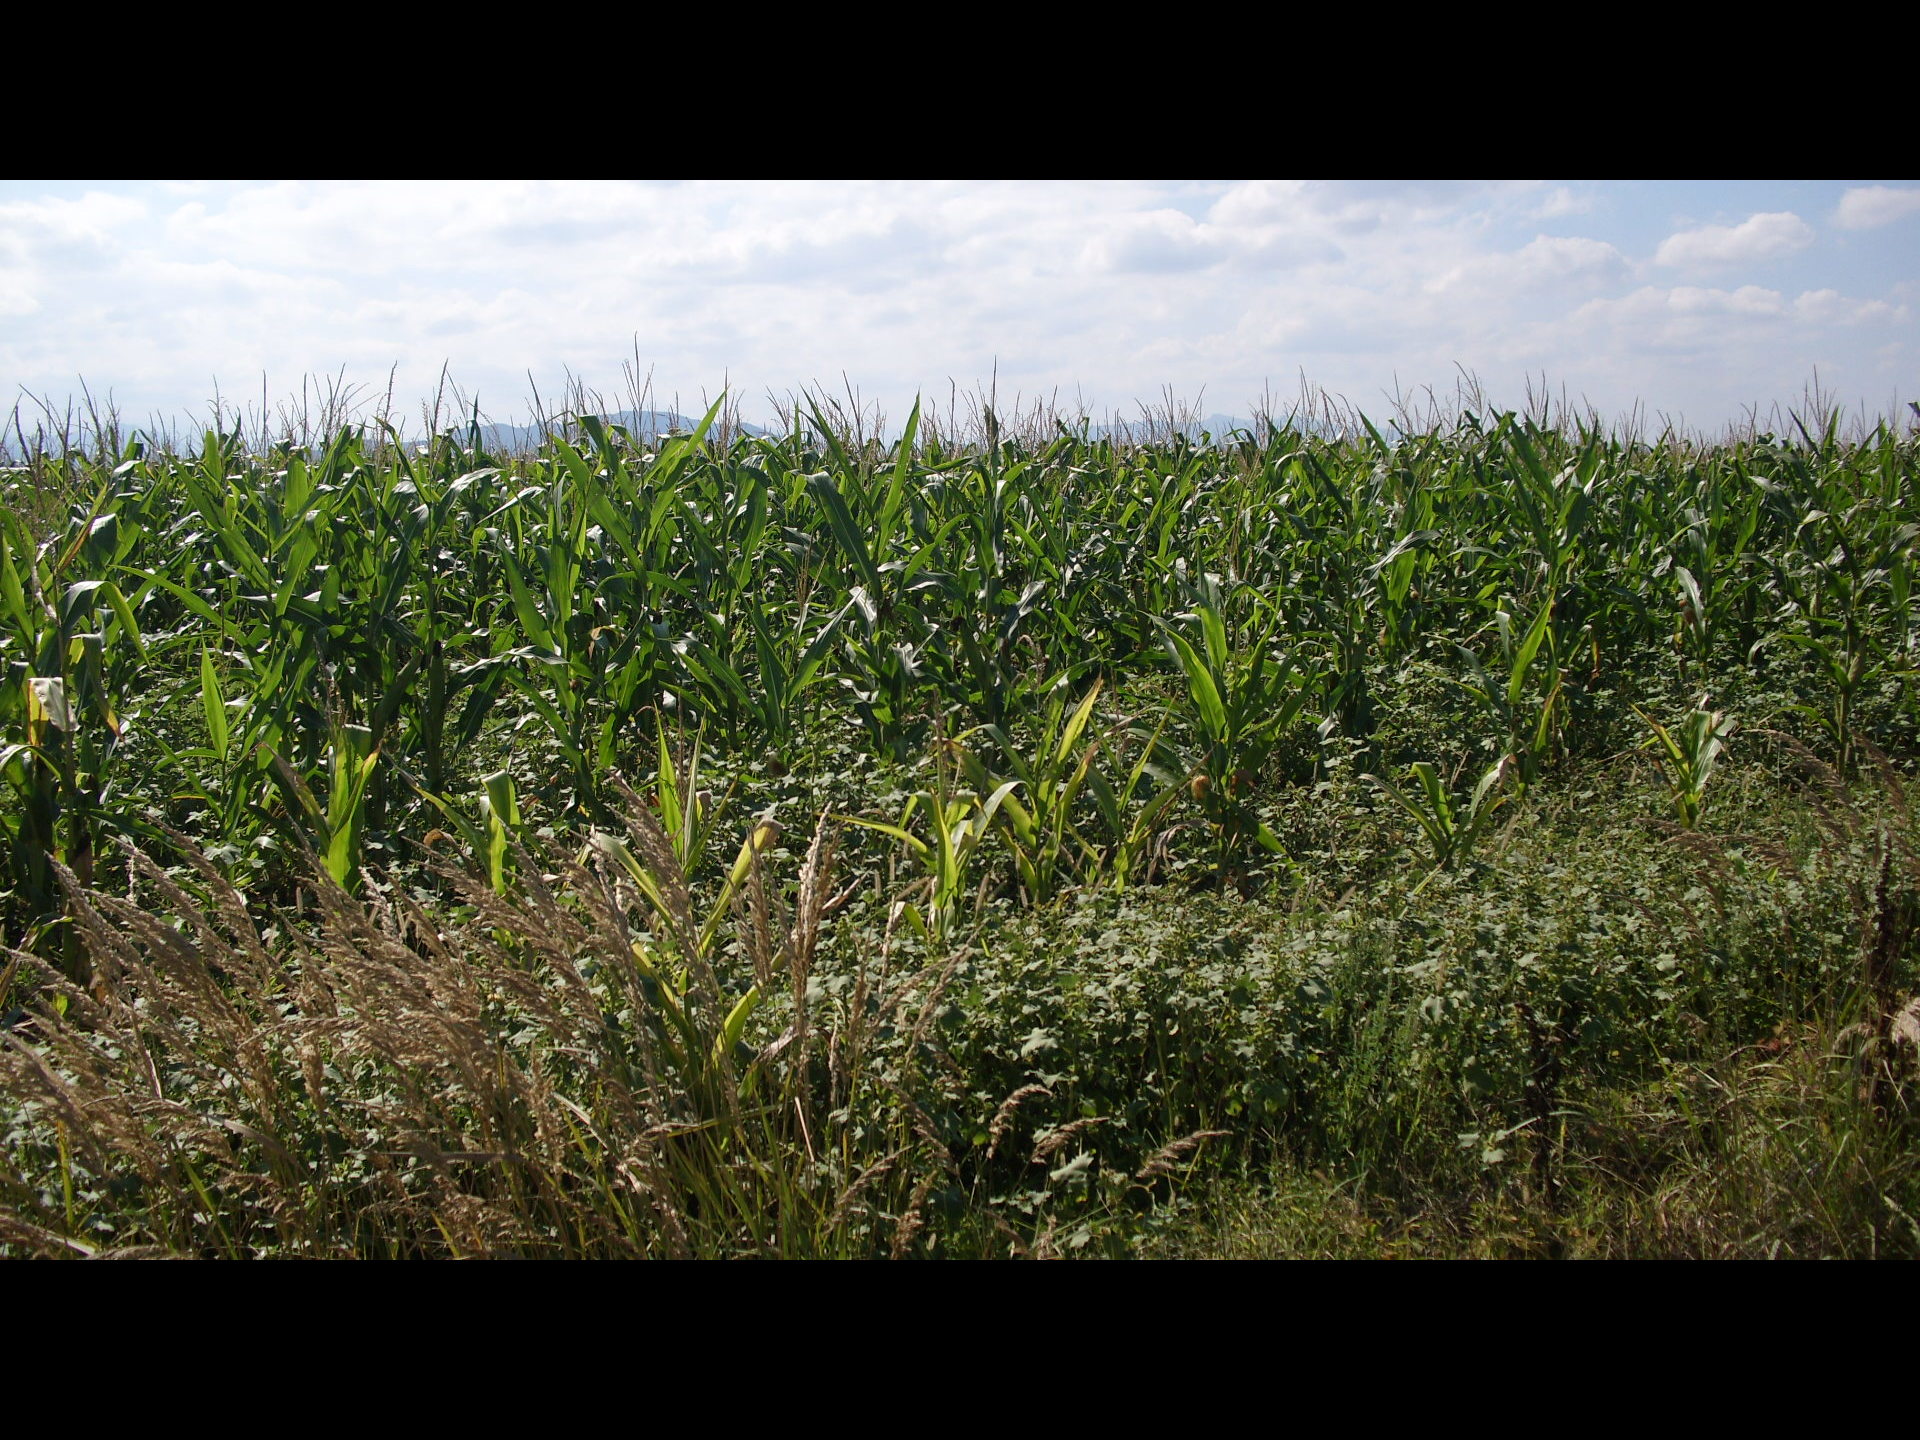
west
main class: Grassland
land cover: Grassland without tree/shrub cover
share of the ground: > 75 %
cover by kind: herbaceous plants 100 %
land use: Agriculture (excluding fallow land and kitchen gardens)
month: August
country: BG
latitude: 43.5862
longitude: 22.9801
